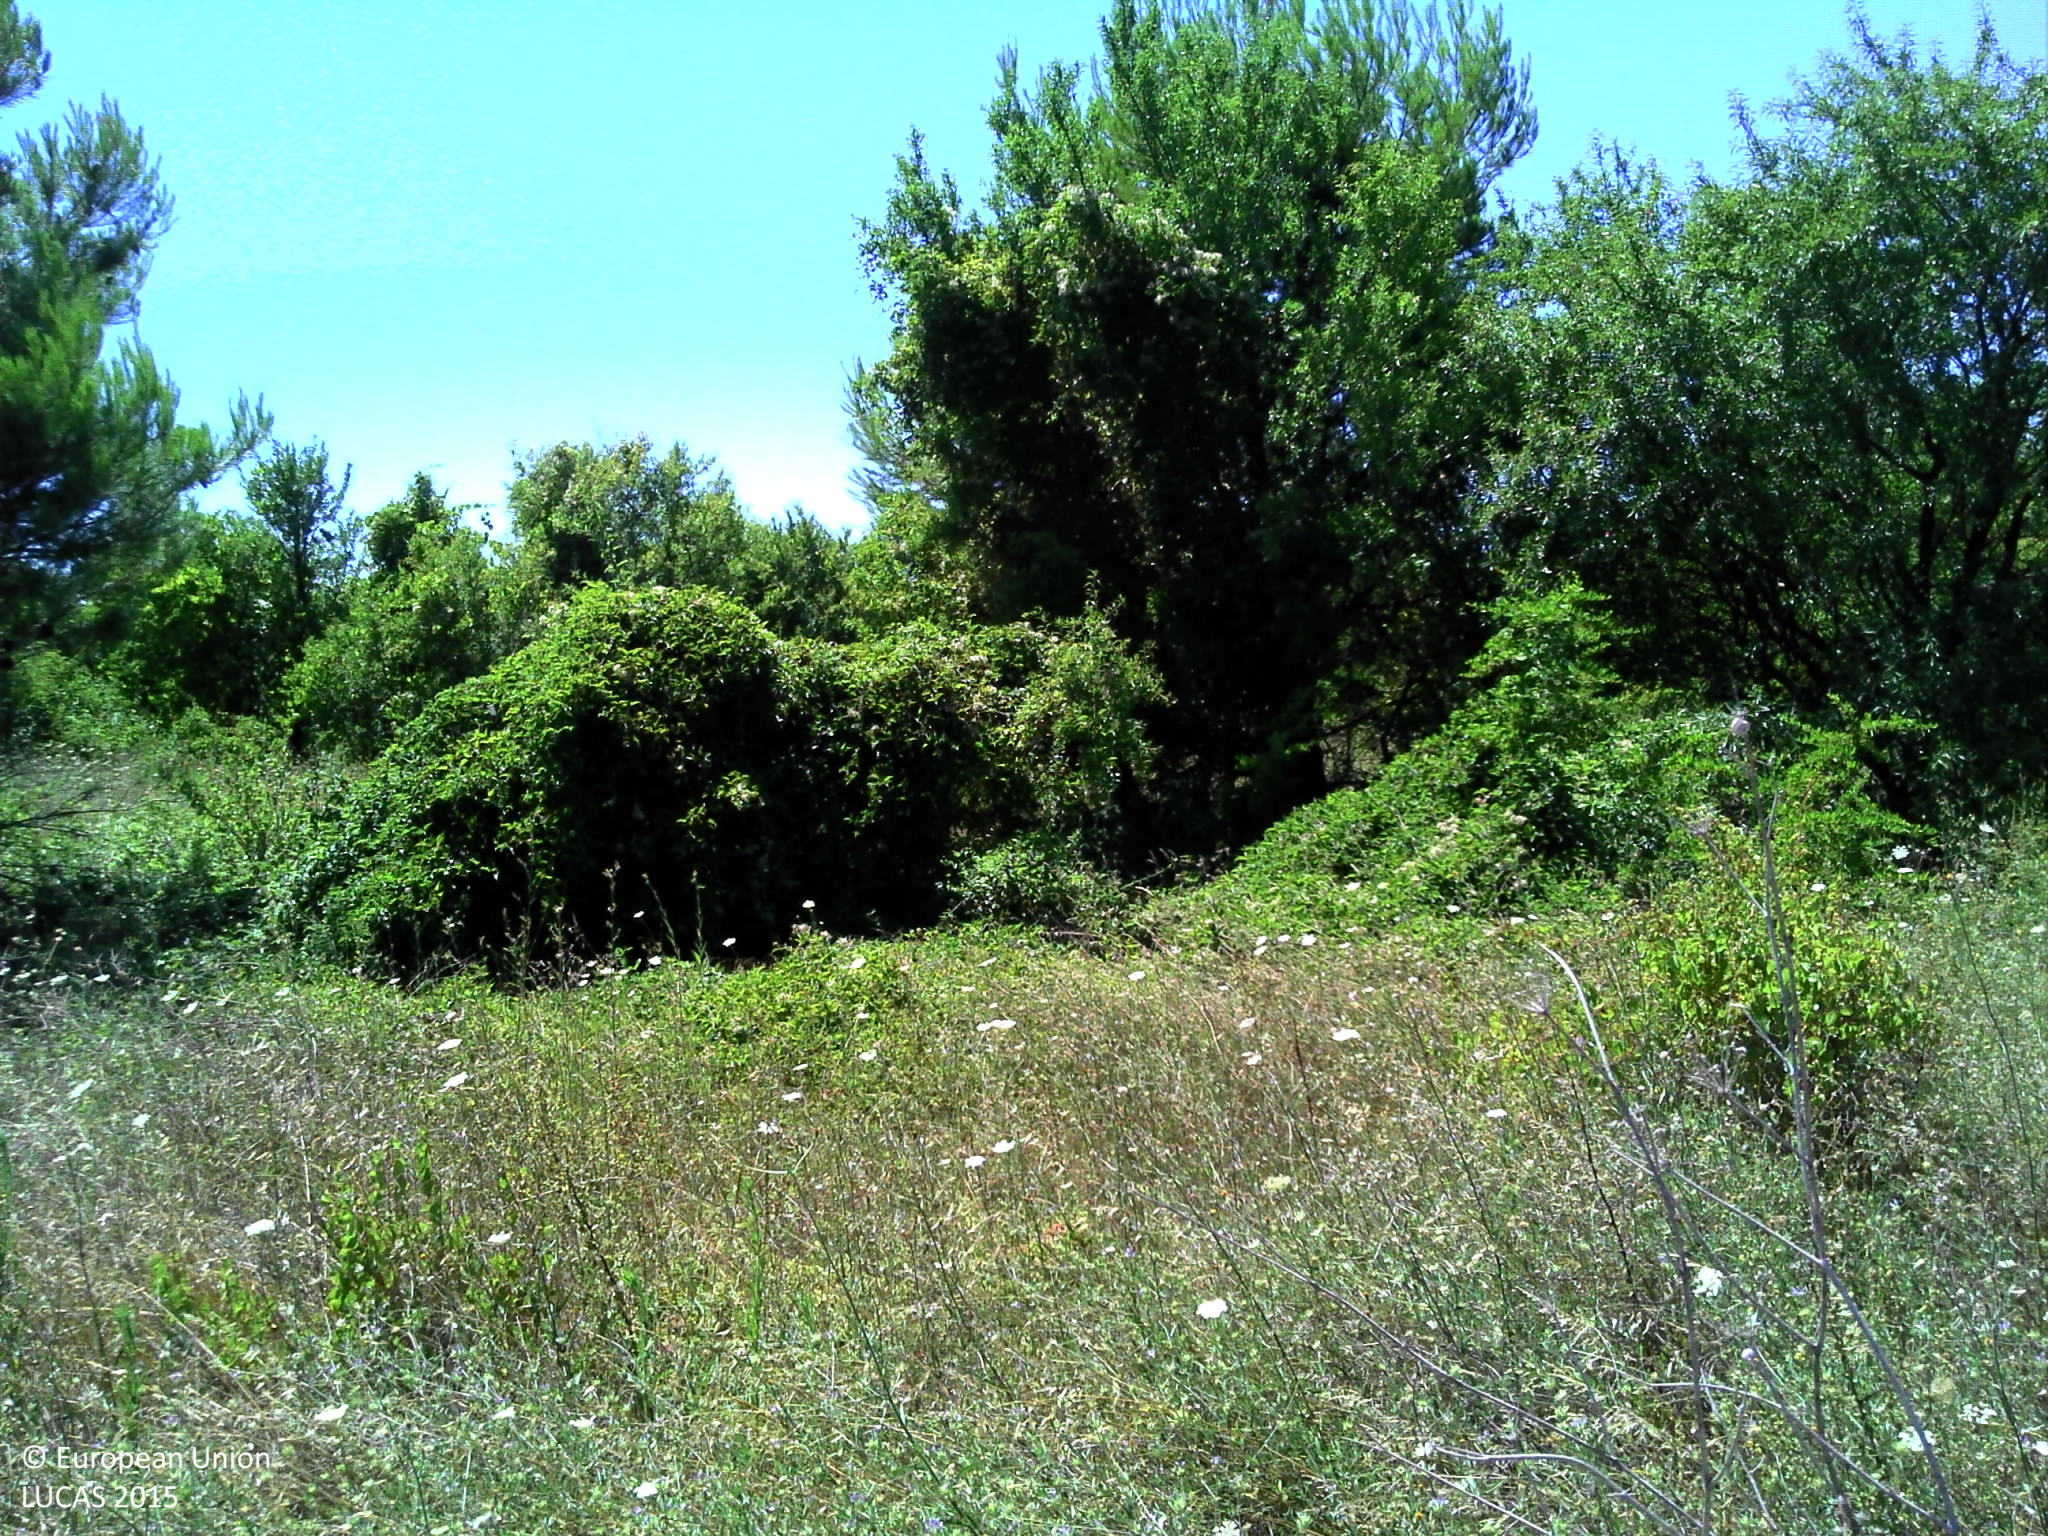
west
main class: Shrubland
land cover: Shrubland with sparse tree cover
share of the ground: > 75 %
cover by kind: herbaceous plants 60 %, shrubs 30 %, broadleaved forest trees 5 %, unconsolidated bare surface 5 %
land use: Semi-natural and natural areas not in use
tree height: < 5 m
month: July
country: FR
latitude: 43.8755
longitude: 5.1428
